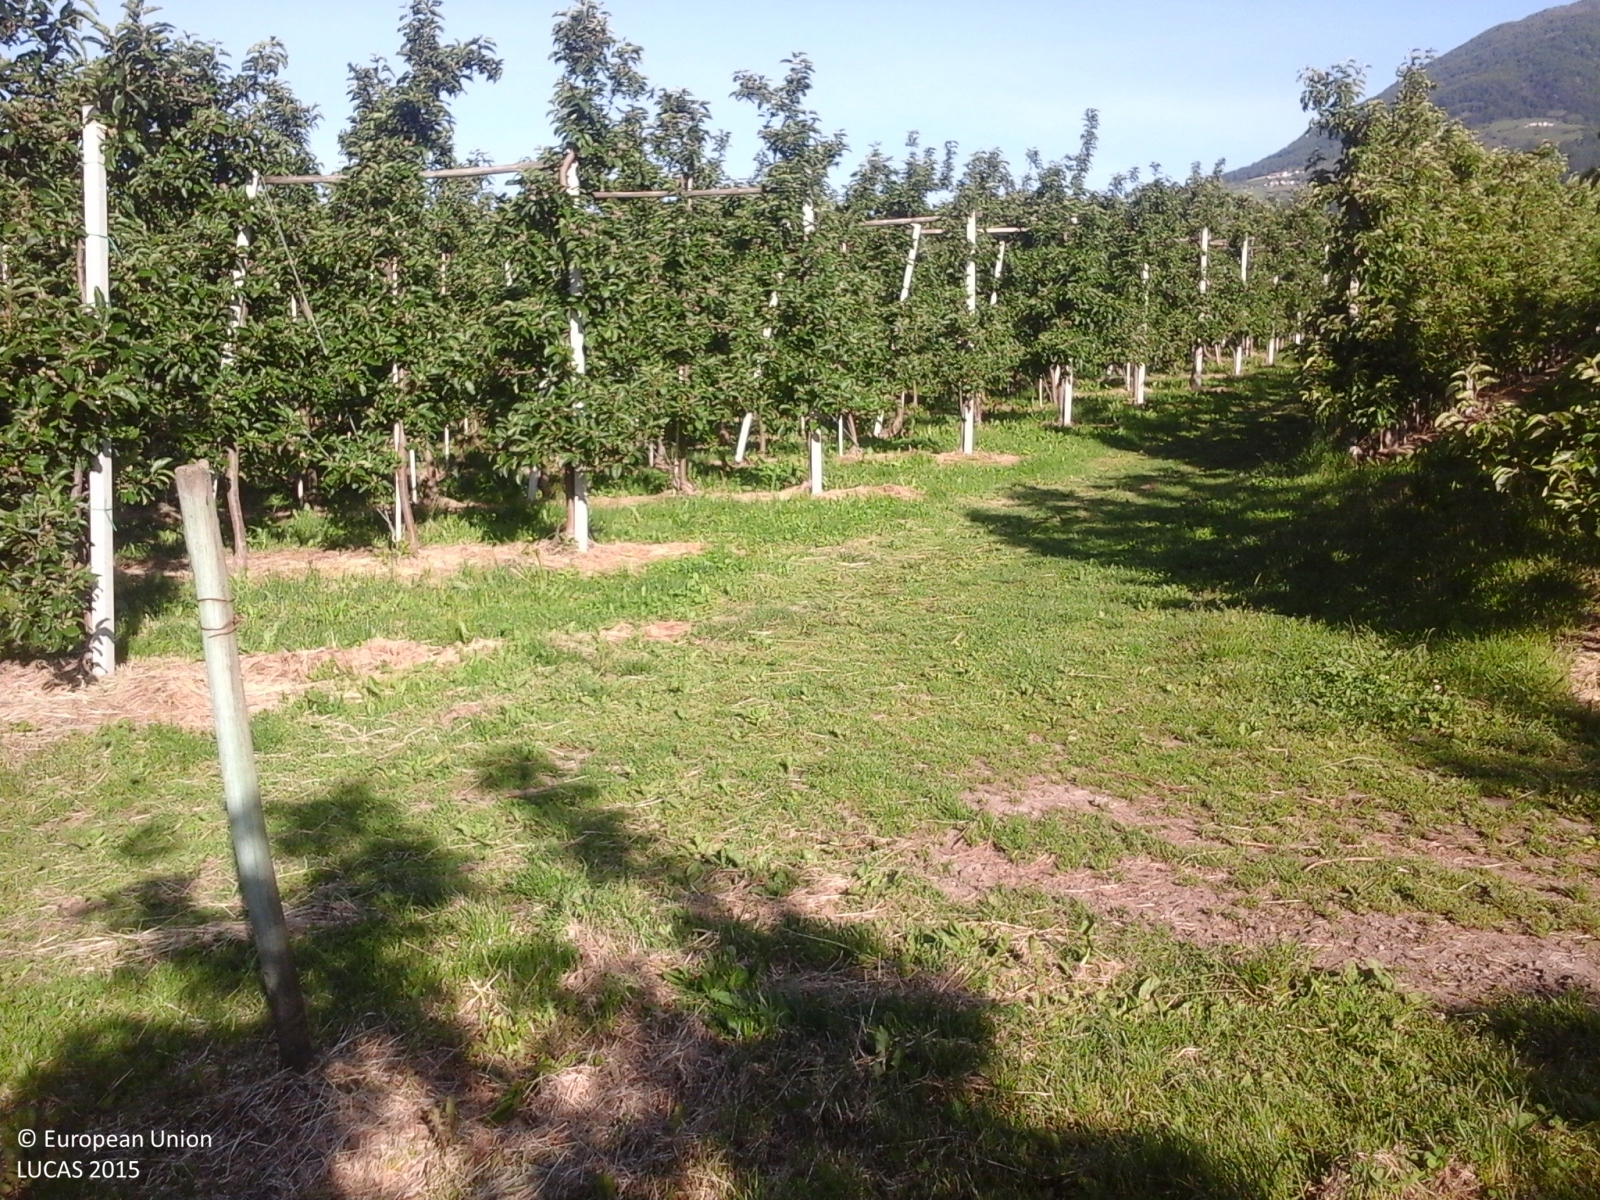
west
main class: Cropland
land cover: Apple fruit
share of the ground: > 75 %
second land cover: Grassland without tree/shrub cover
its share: > 75 %
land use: Agriculture (excluding fallow land and kitchen gardens)
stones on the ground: < 10 %
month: May
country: IT
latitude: 46.6188
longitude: 10.7434
